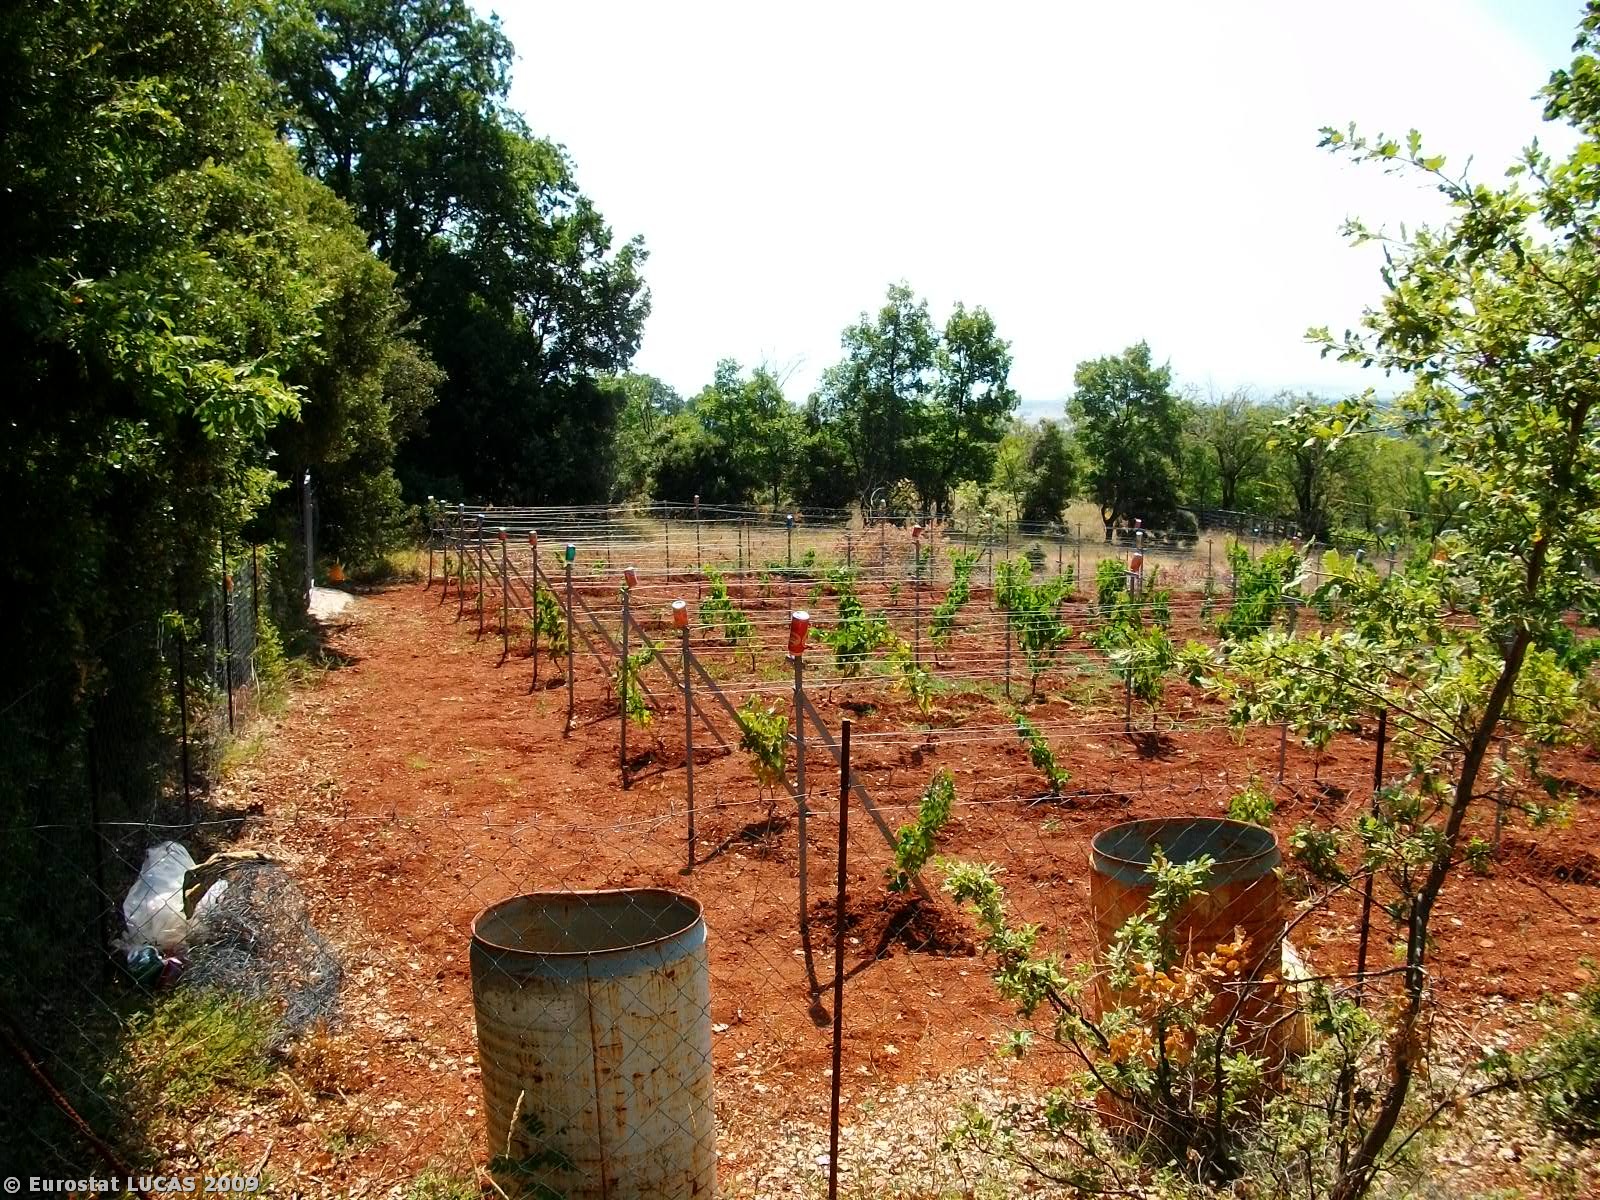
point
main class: Cropland
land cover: Vineyards
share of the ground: 10 - 25 %
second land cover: Bare land
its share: 50 - 75 %
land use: Agriculture (excluding fallow land and kitchen gardens)
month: July
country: GR
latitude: 40.2364
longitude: 21.7328
